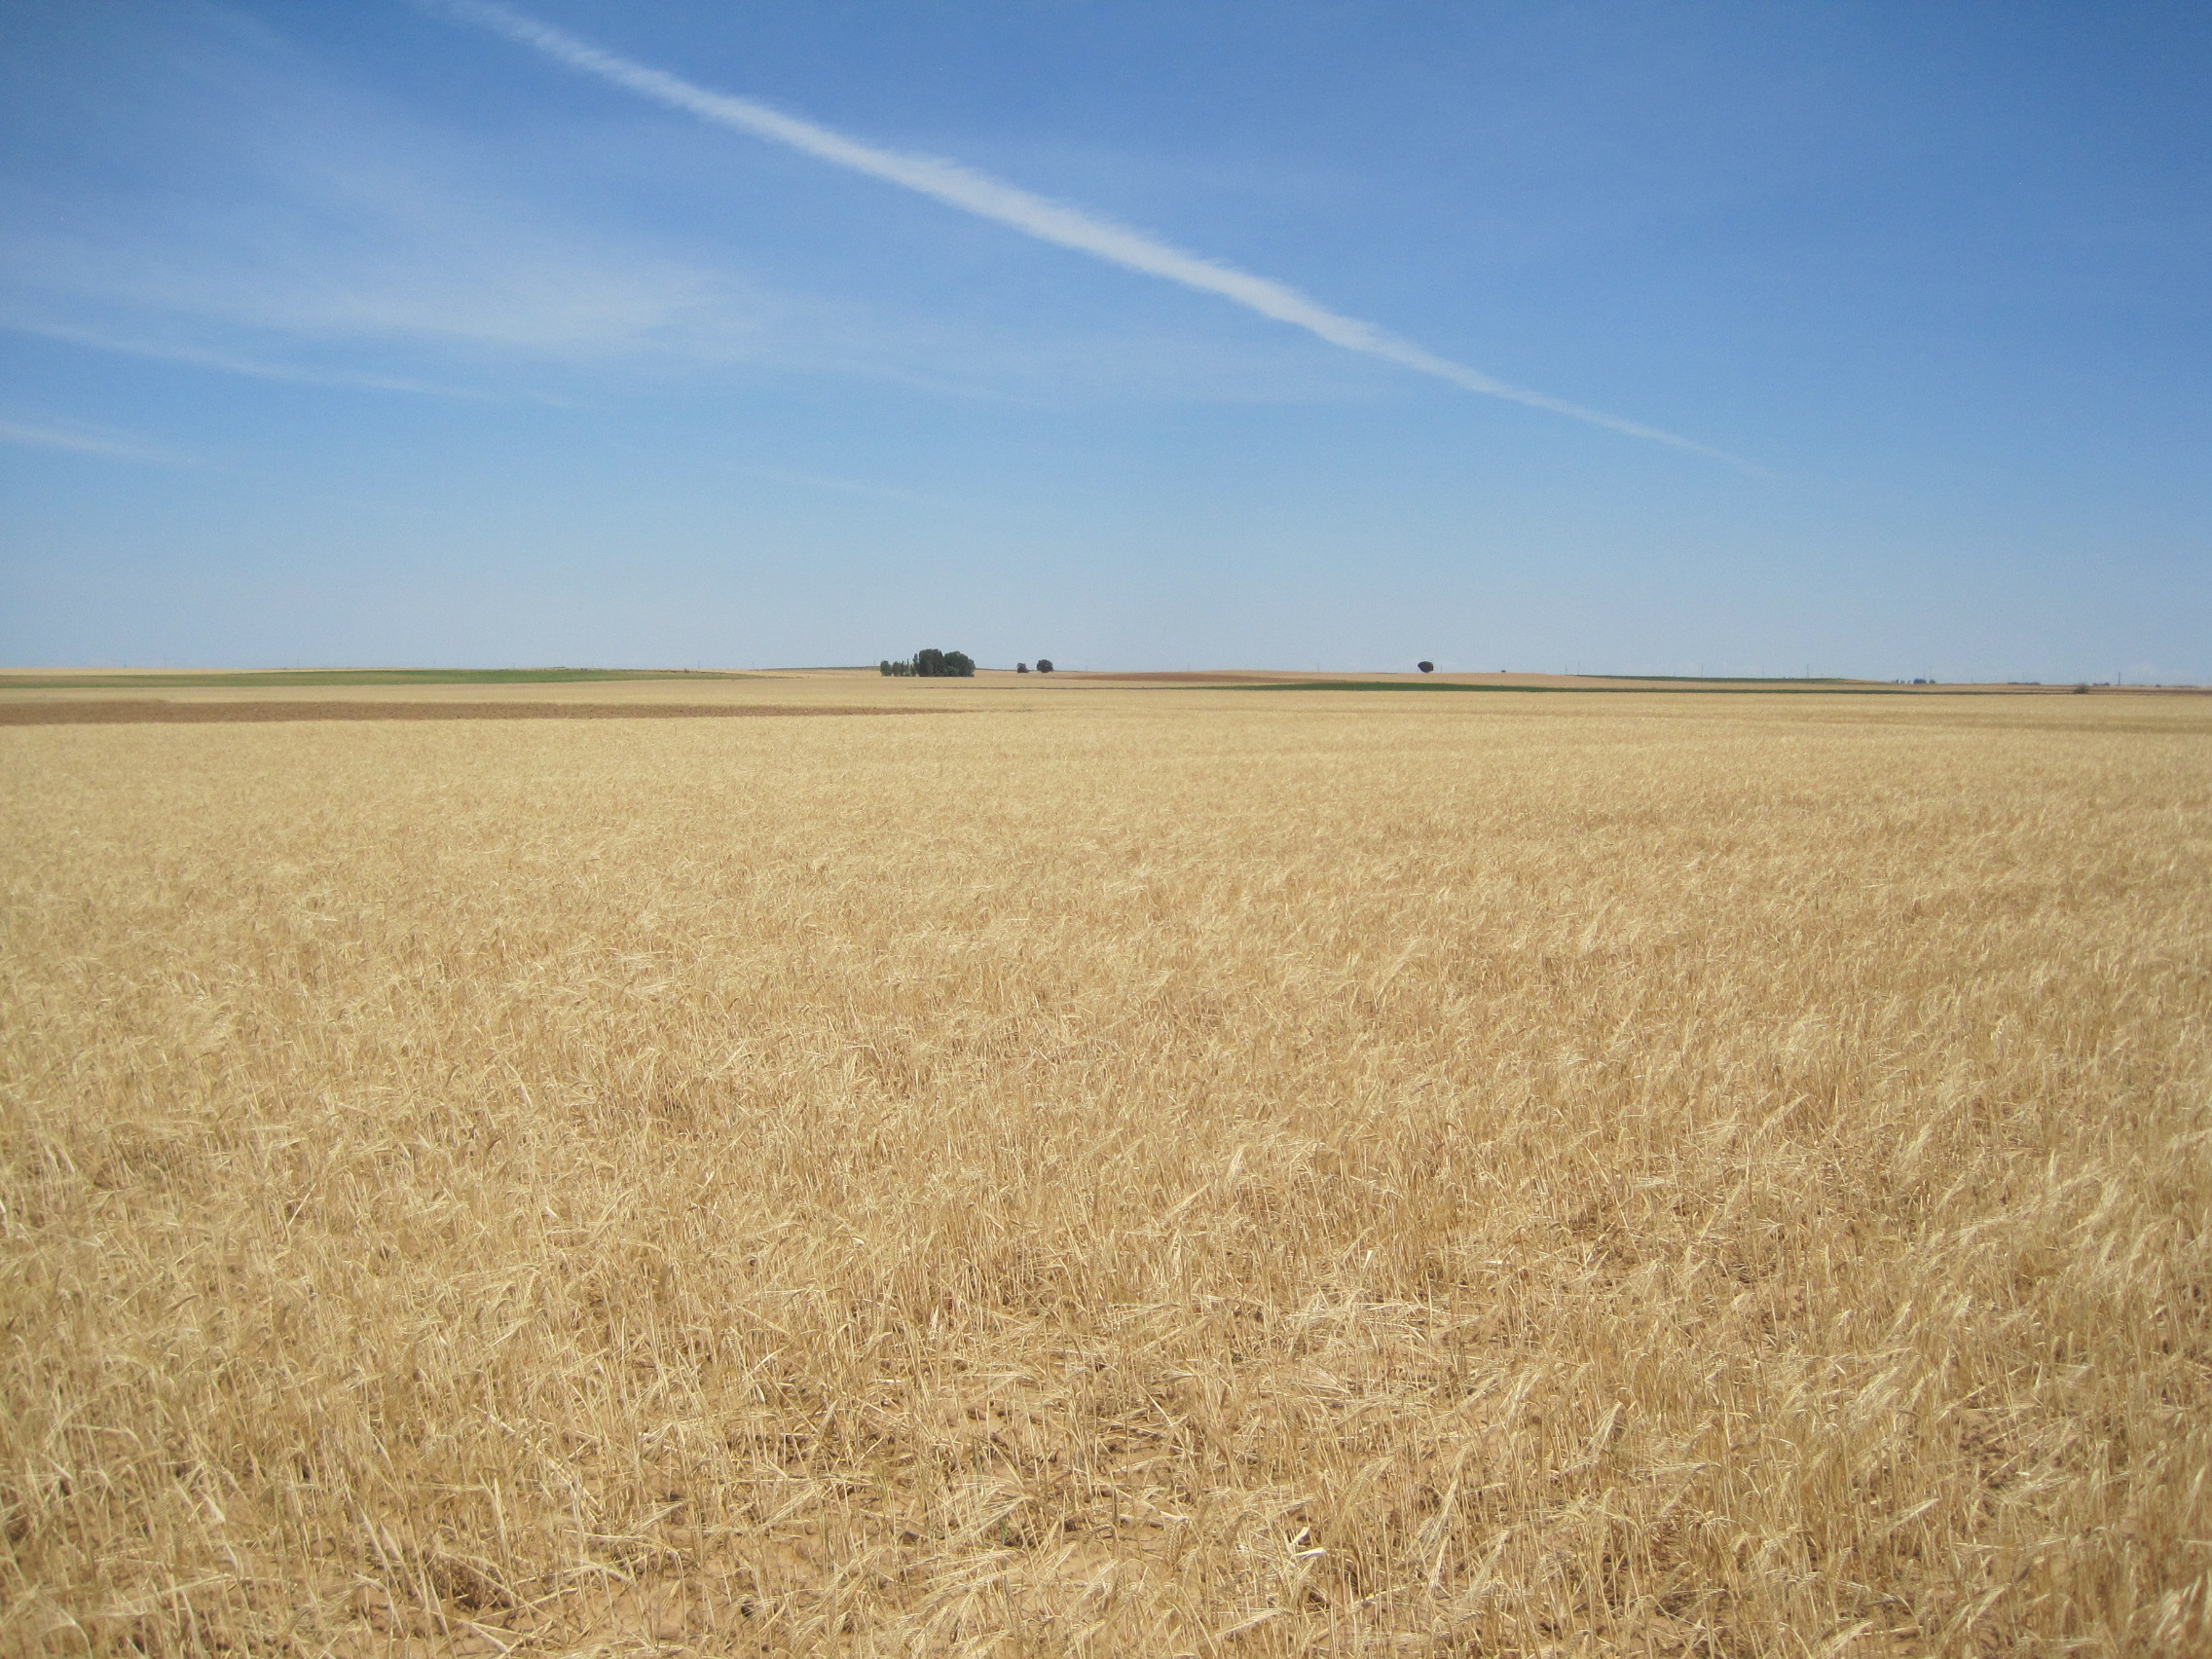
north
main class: Cropland
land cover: Barley
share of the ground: > 75 %
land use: Agriculture (excluding fallow land and kitchen gardens)
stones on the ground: < 10 %
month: June
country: ES
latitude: 41.8058
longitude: -5.2340
